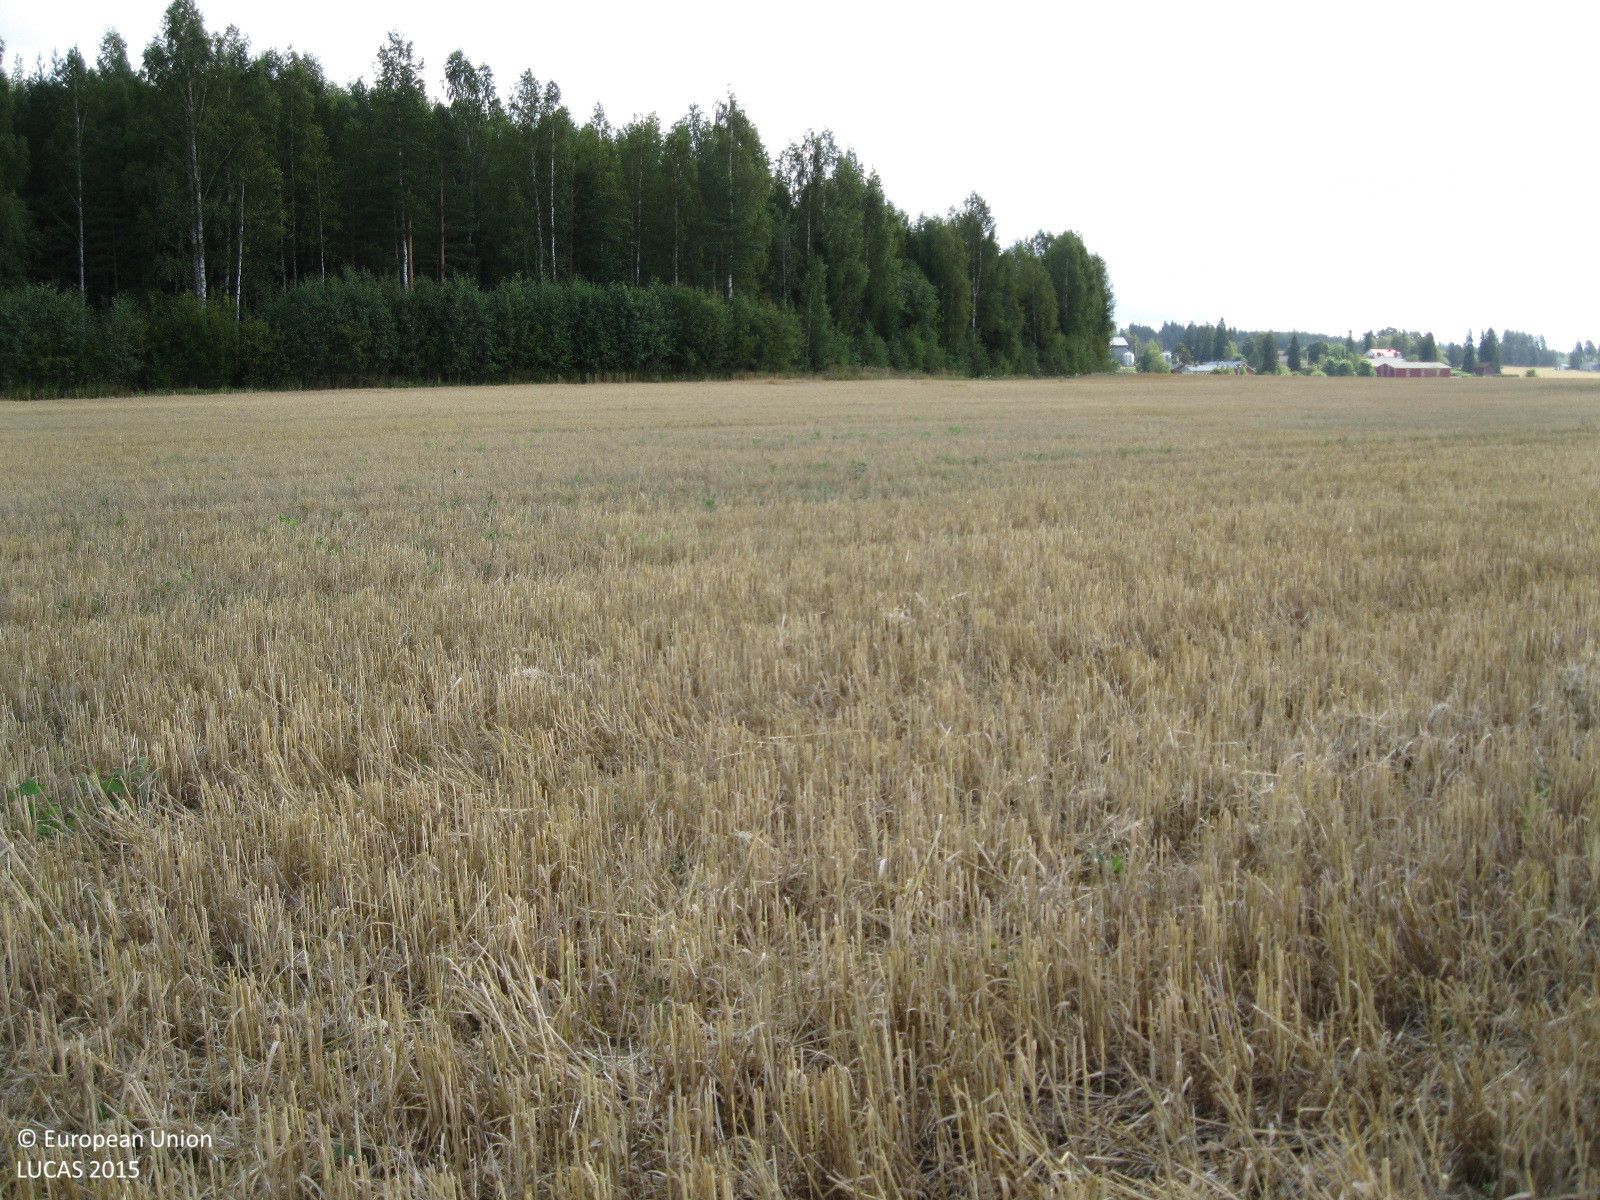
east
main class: Cropland
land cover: Common wheat
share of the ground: > 75 %
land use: Agriculture (excluding fallow land and kitchen gardens)
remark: Harvested field
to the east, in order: Common wheat; Grass margins; Broadleaved woodland; Ditches and canals; Other mixed woodland; Spruce dominated mixed woodland; Tracks; Spruce dominated mixed woodland
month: September
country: FI
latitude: 60.8324
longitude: 24.9202
